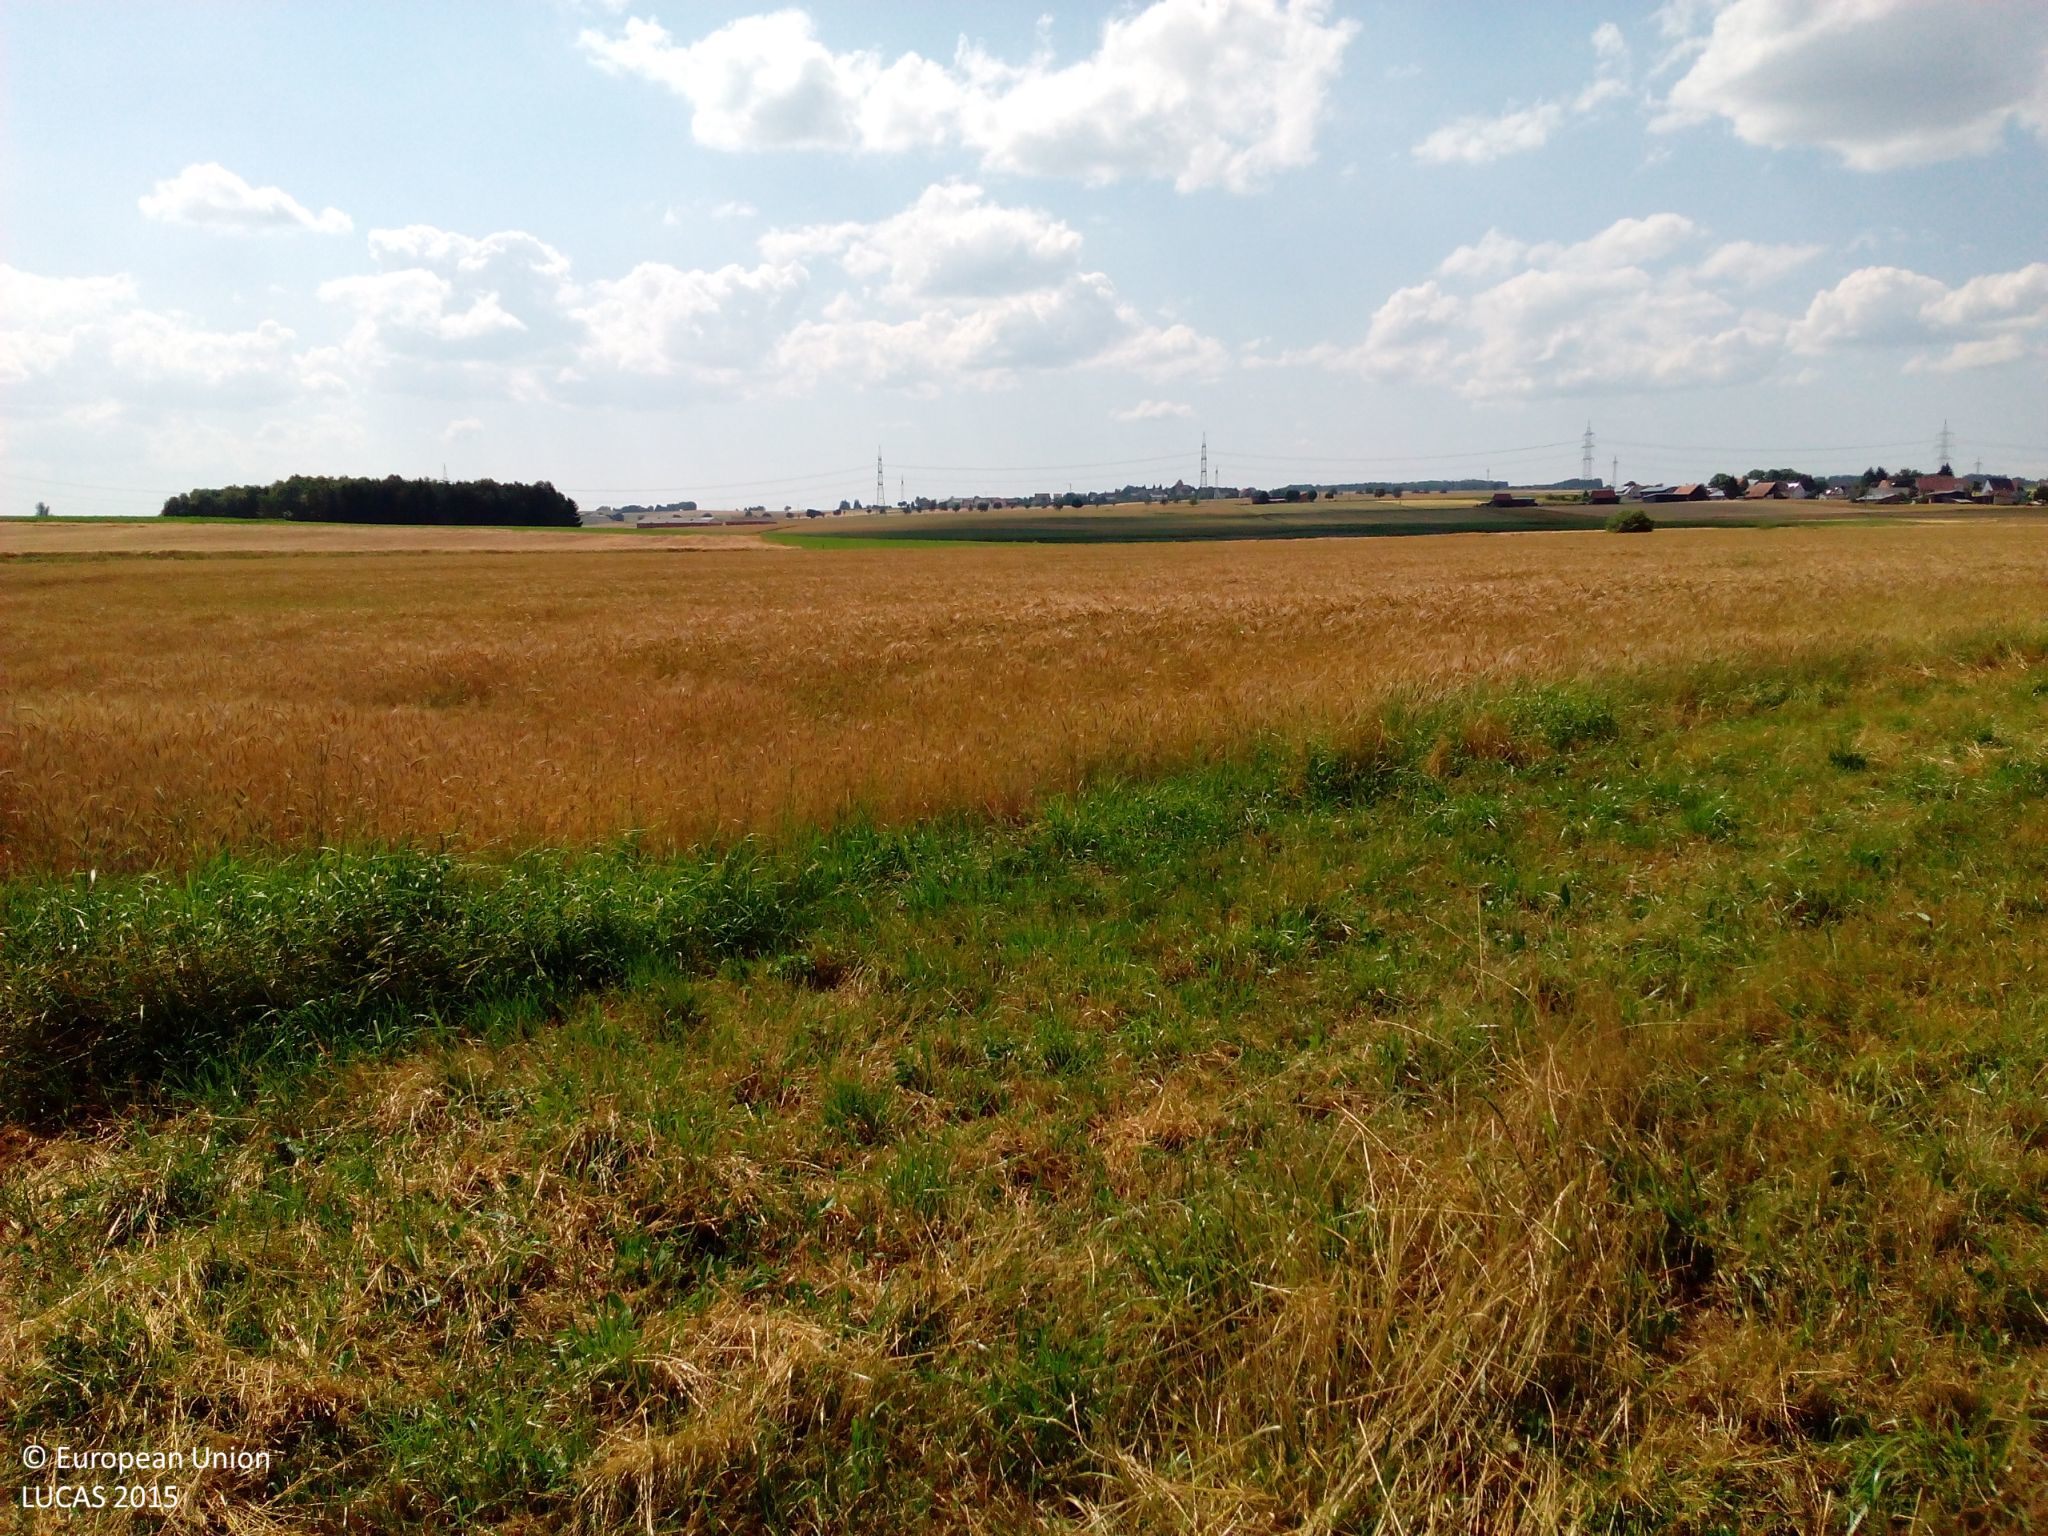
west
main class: Grassland
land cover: Grassland without tree/shrub cover
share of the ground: > 75 %
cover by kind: herbaceous plants 100 %
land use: Agriculture (excluding fallow land and kitchen gardens)
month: July
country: DE
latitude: 47.9806
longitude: 8.5942
